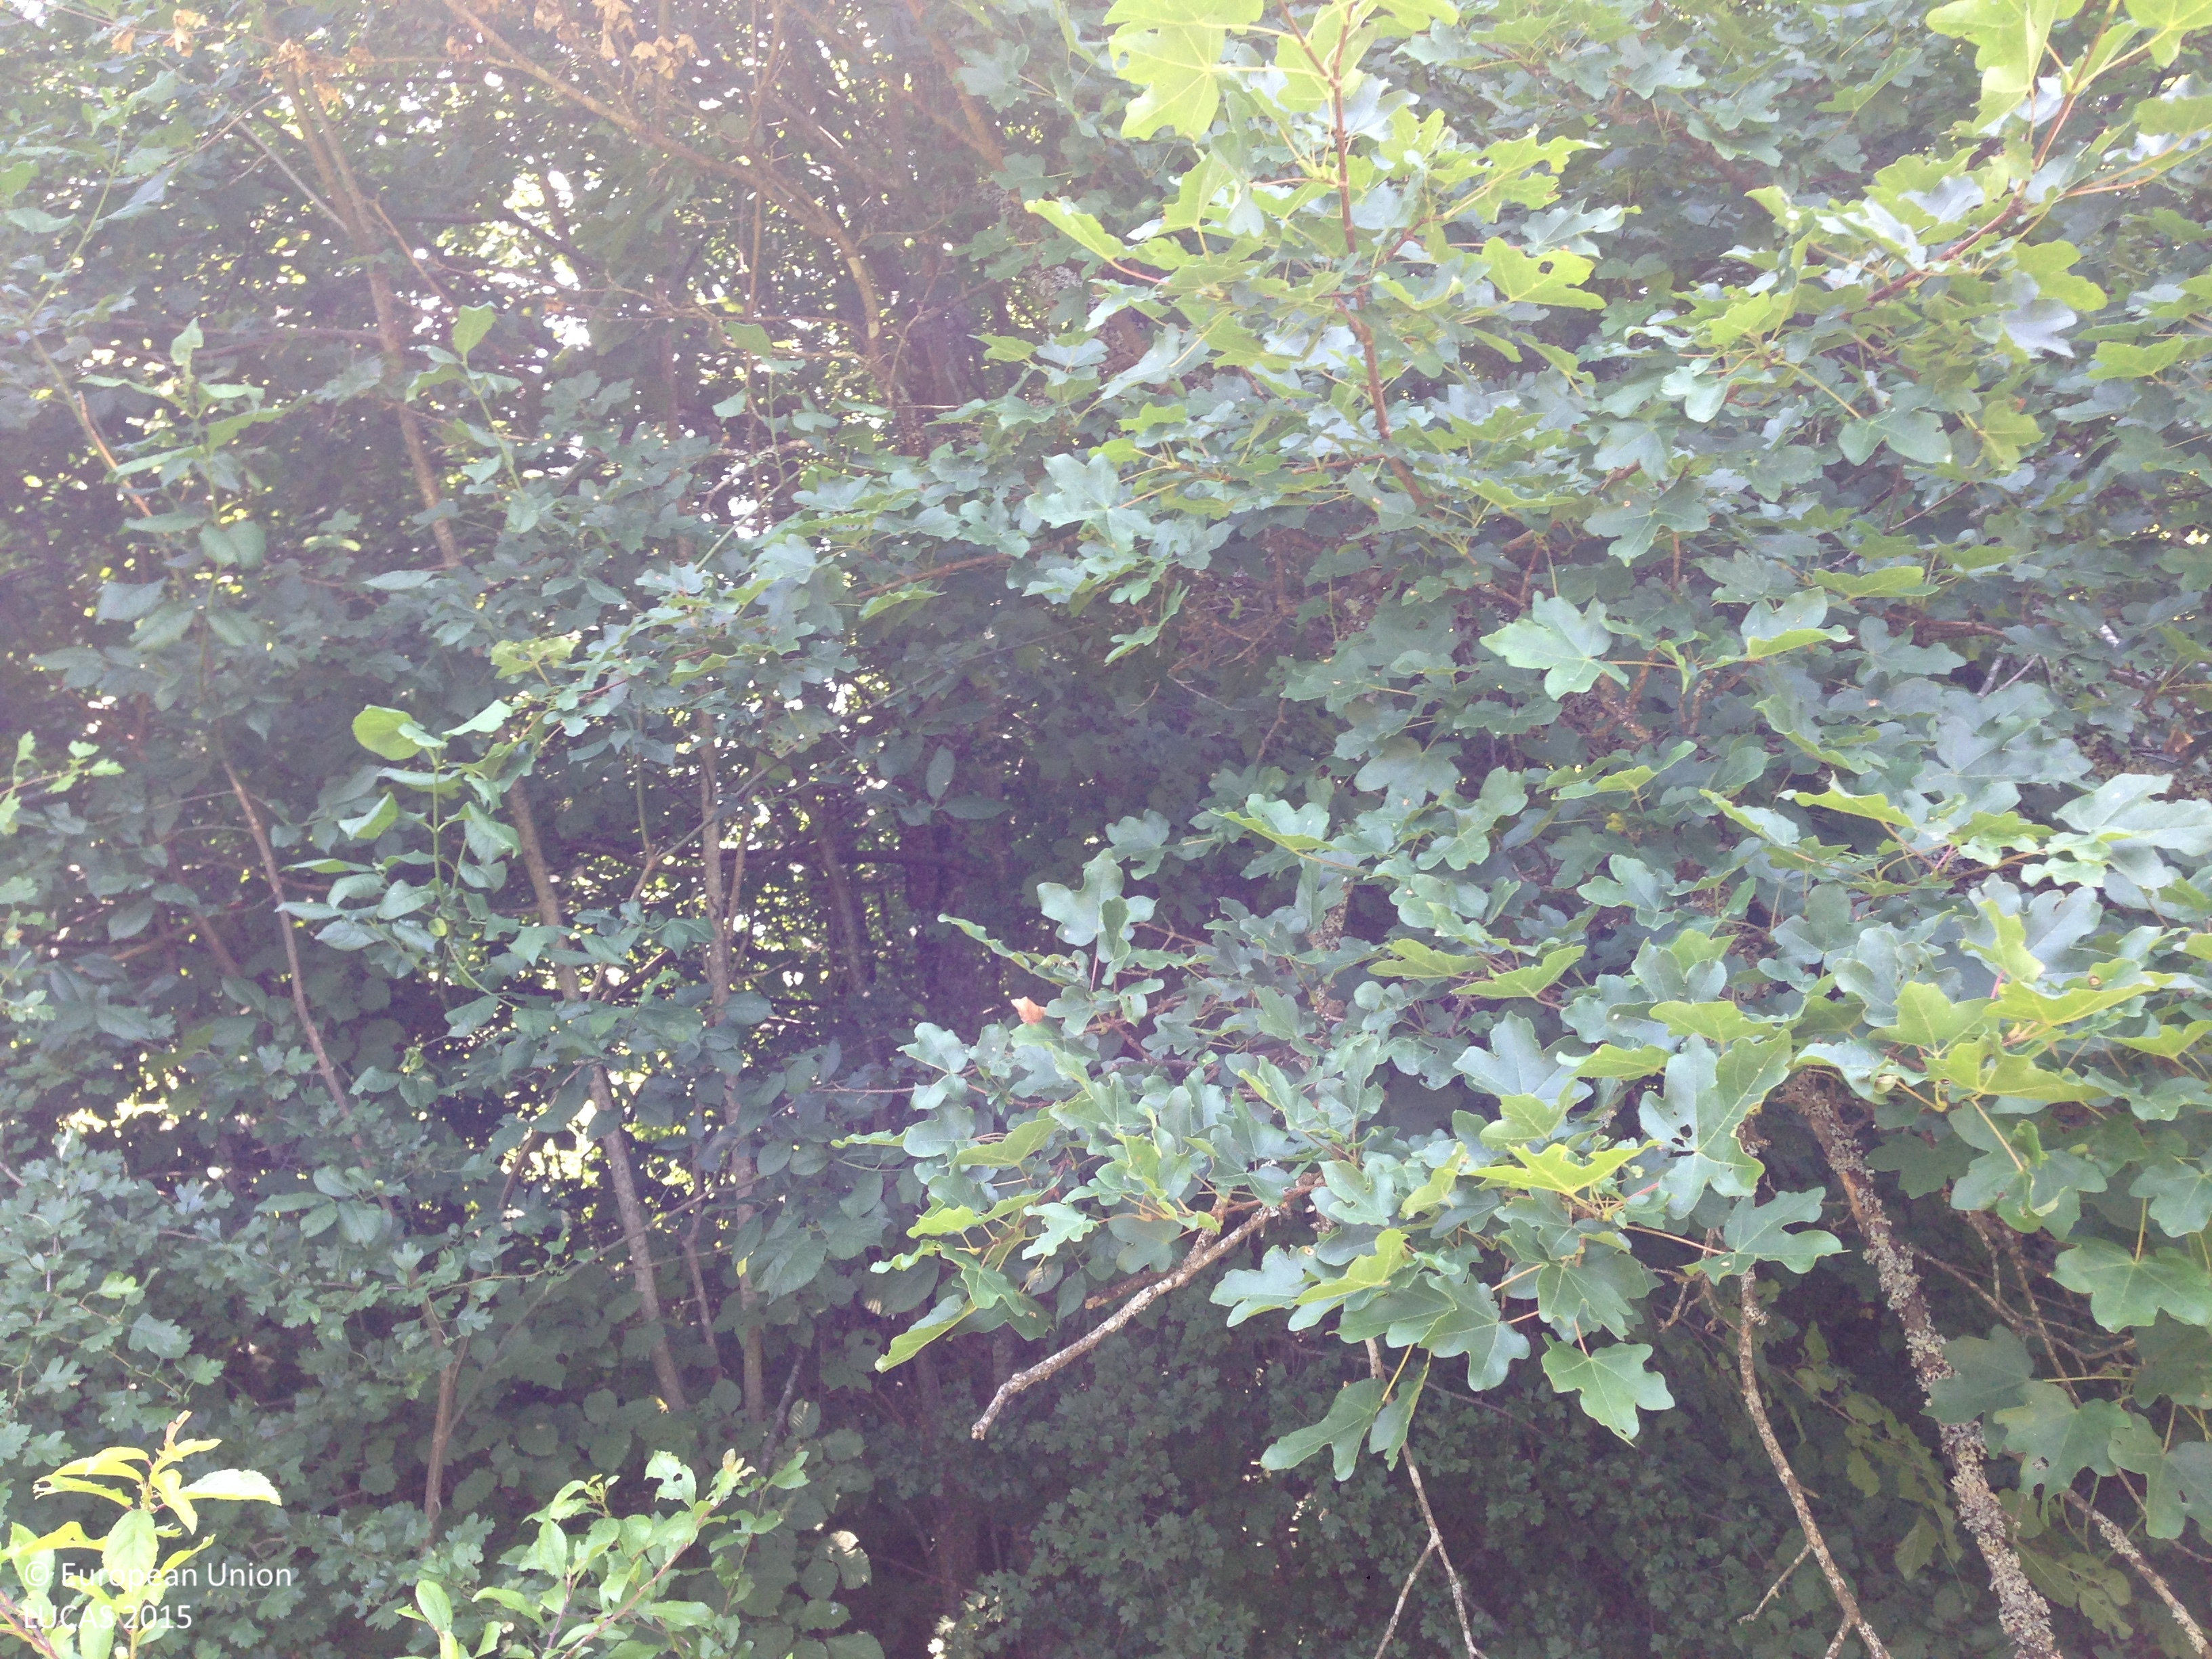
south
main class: Woodland
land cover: Broadleaved woodland
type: thermophilous deciduous forest
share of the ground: 25 - 50 %
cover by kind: herbaceous plants 40 %, broadleaved forest trees 30 %, shrubs 30 %
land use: Forestry
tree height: > 5 m
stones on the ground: < 10 %
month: July
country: HR
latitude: 44.5986
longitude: 15.2217
